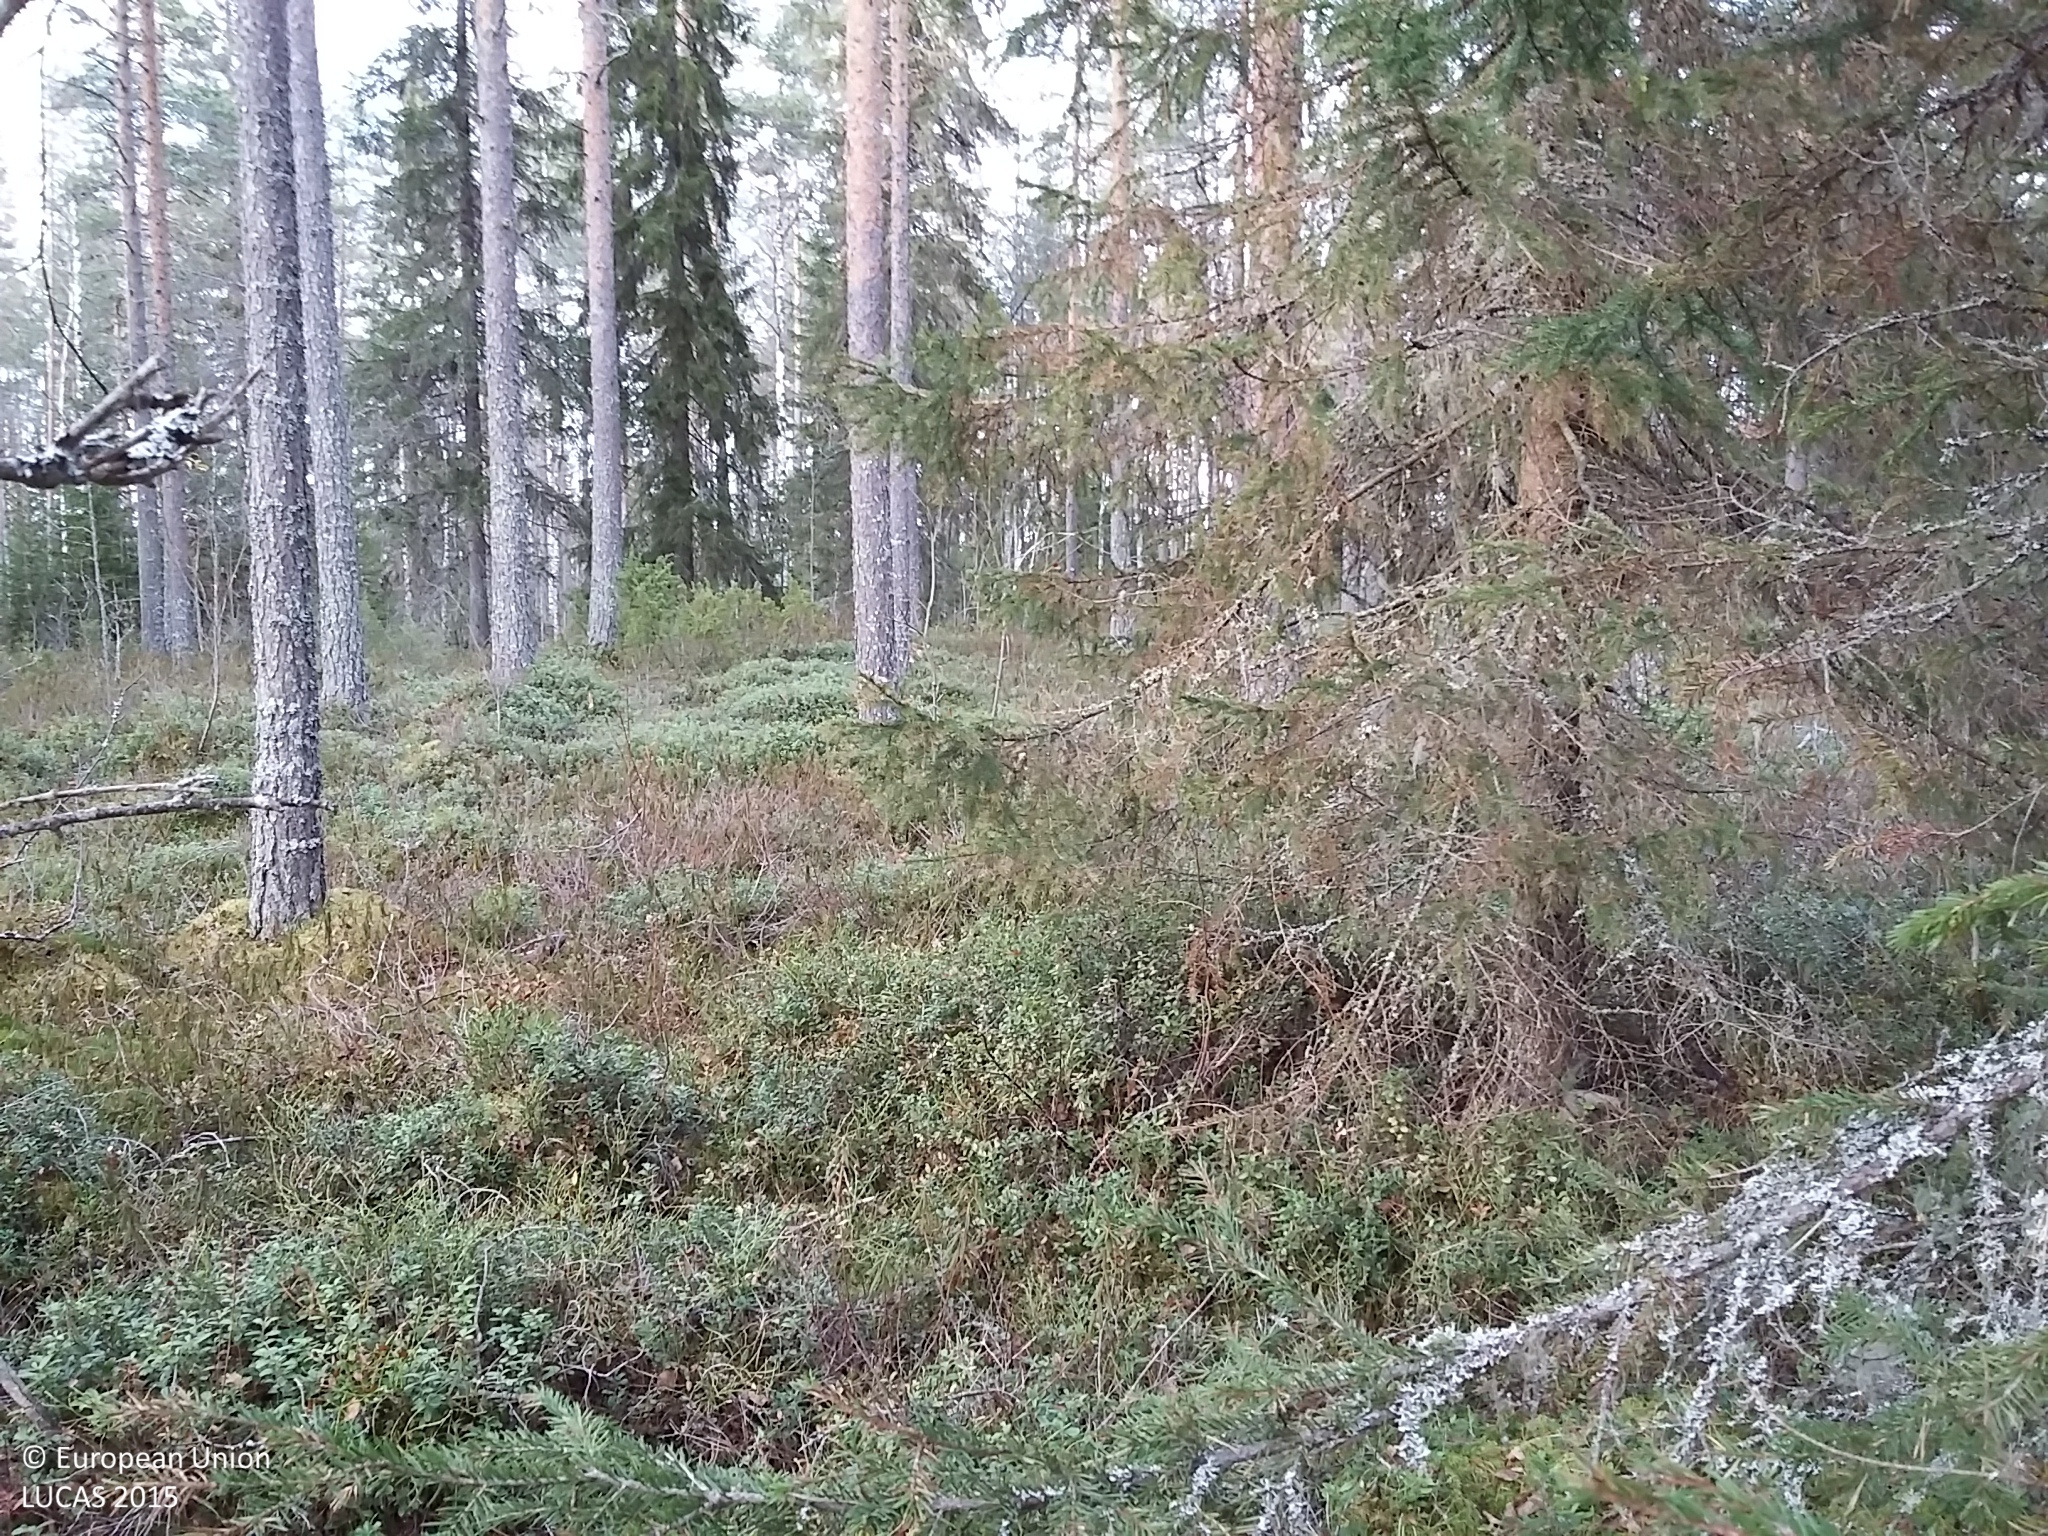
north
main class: Woodland
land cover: Pine dominated mixed woodland
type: boreal forest
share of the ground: > 75 %
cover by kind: coniferous forest trees 60 %, broadleaved forest trees 25 %, shrubs 5 %, herbaceous plants 5 %, lichens and mosses 5 %
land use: Forestry
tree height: > 5 m
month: October
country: FI
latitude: 63.9983
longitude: 24.9469
